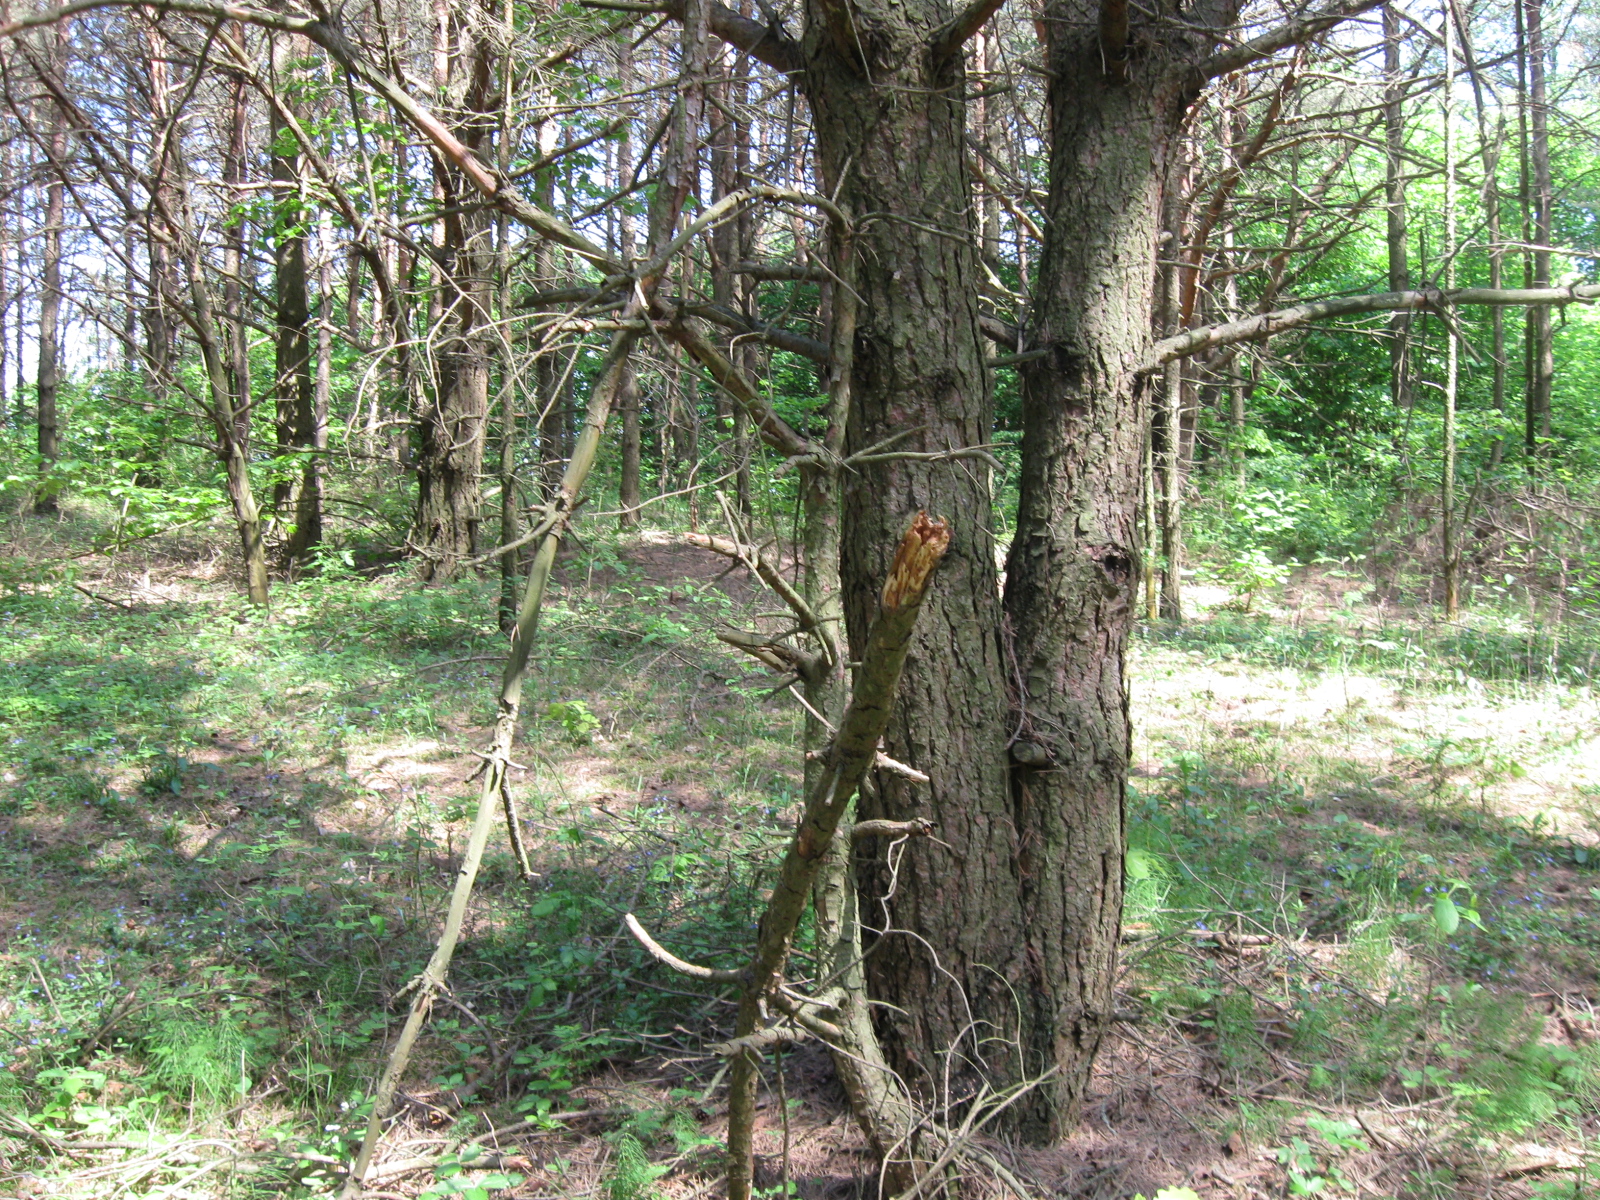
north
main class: Woodland
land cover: Pine dominated coniferous woodland
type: hemiboreal forest and nemoral coniferous forest and mixed broadleaved-coniferous forest
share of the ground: > 75 %
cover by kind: coniferous forest trees 85 %, broadleaved forest trees 10 %, herbaceous plants 5 %
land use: Forestry
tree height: > 5 m
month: June
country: LT
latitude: 54.2012
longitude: 23.7462
